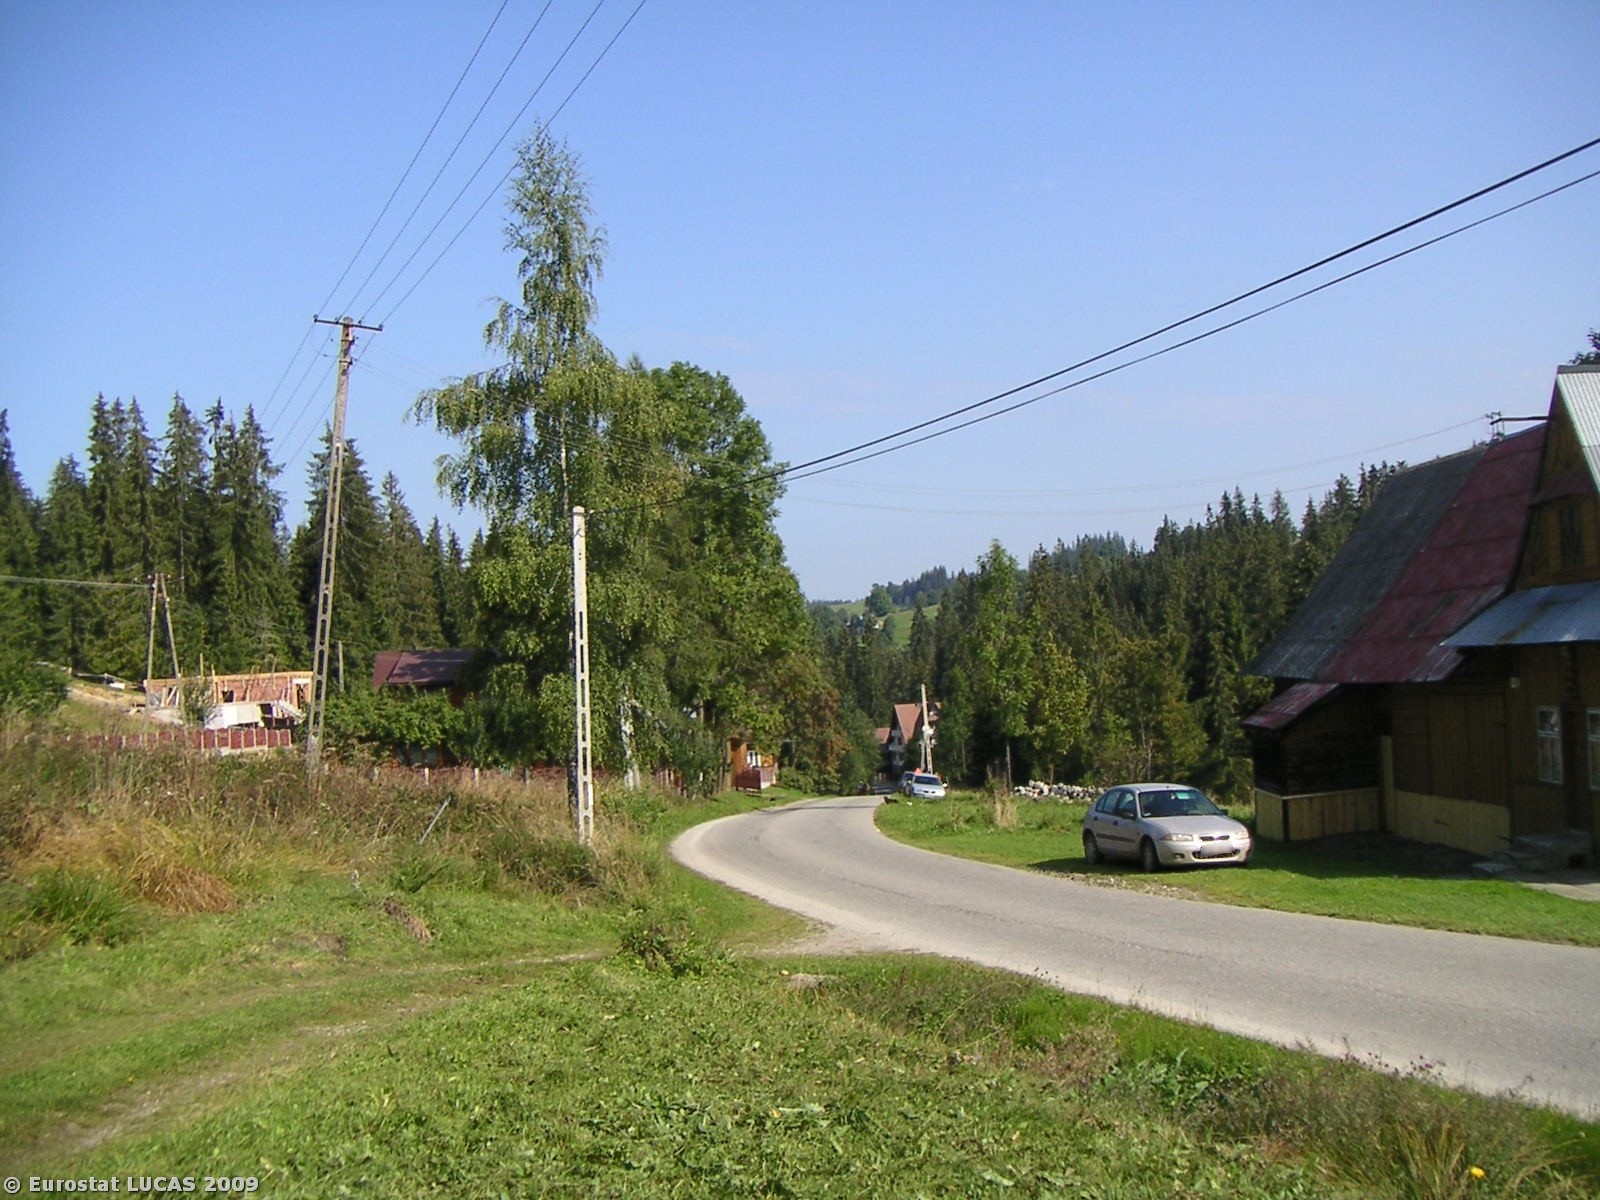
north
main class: Grassland
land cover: Grassland without tree/shrub cover
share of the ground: > 75 %
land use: Agriculture (excluding fallow land and kitchen gardens)
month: September
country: PL
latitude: 49.3568
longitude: 20.0687
